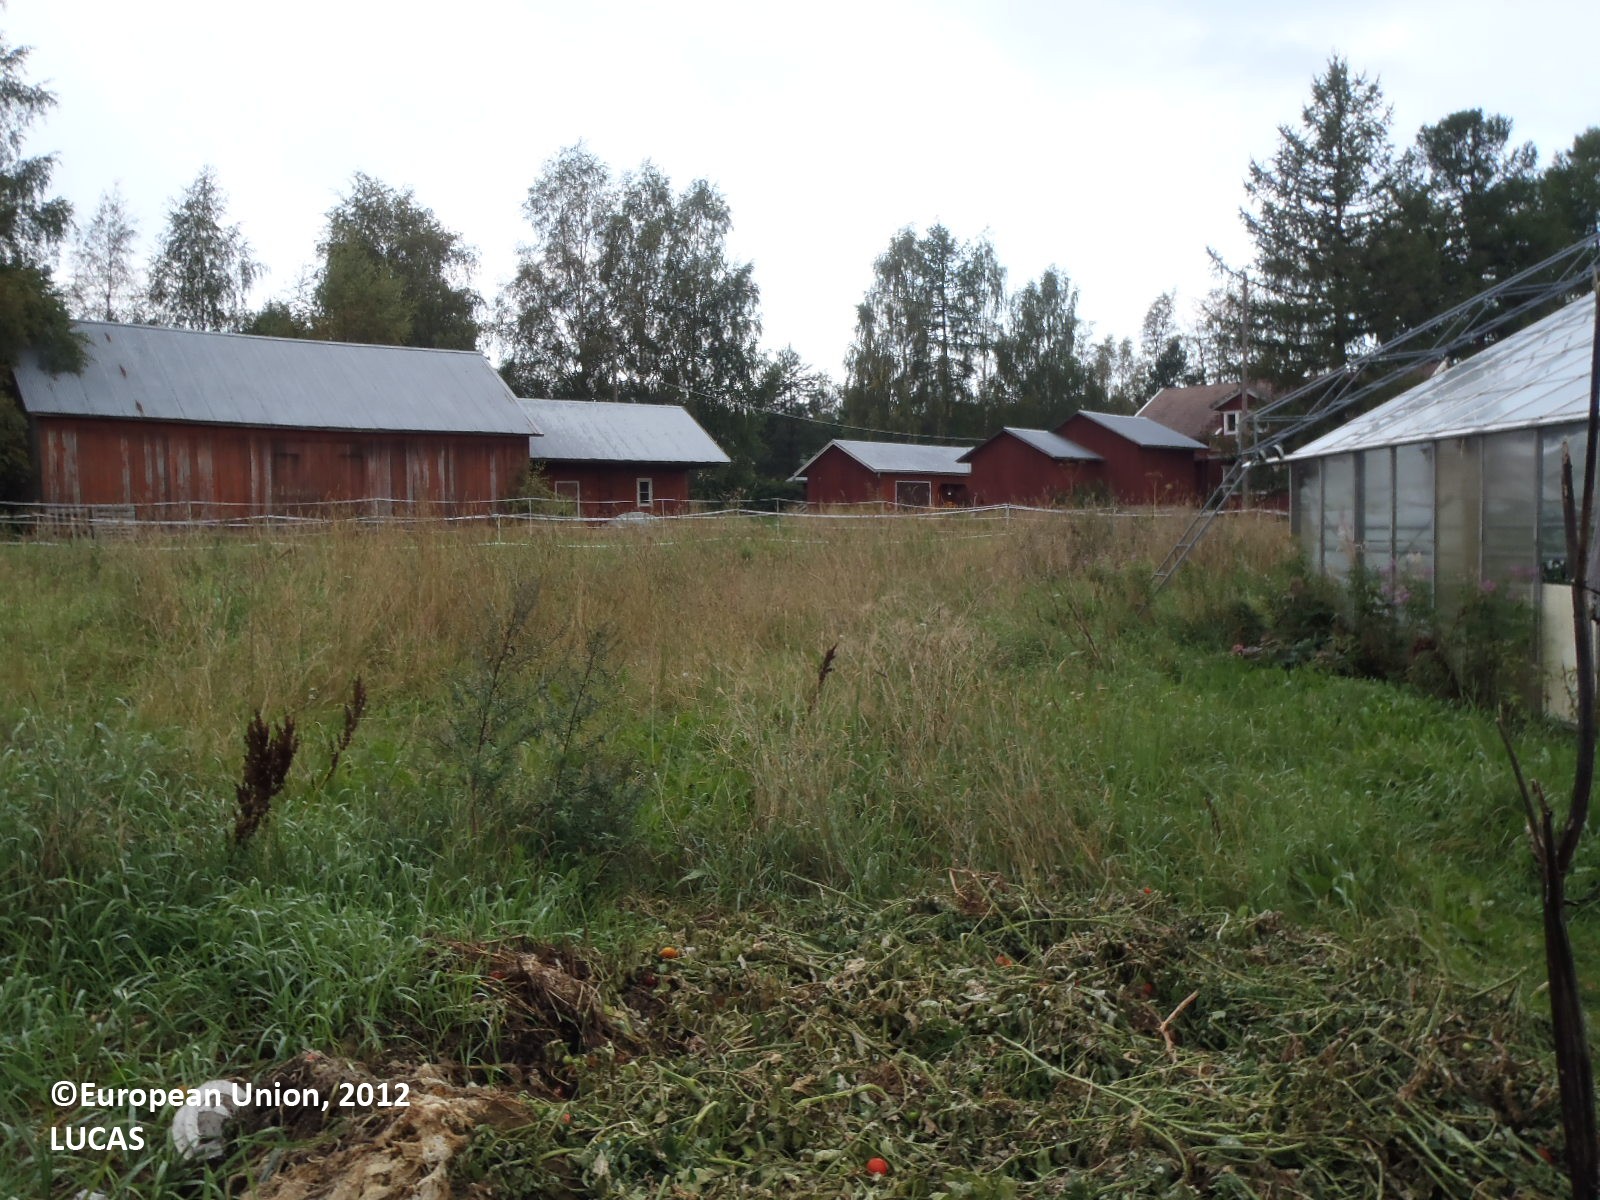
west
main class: Grassland
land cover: Grassland without tree/shrub cover
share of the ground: > 75 %
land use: Commerce, finance, business
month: August
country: FI
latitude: 60.8738
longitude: 22.3877
